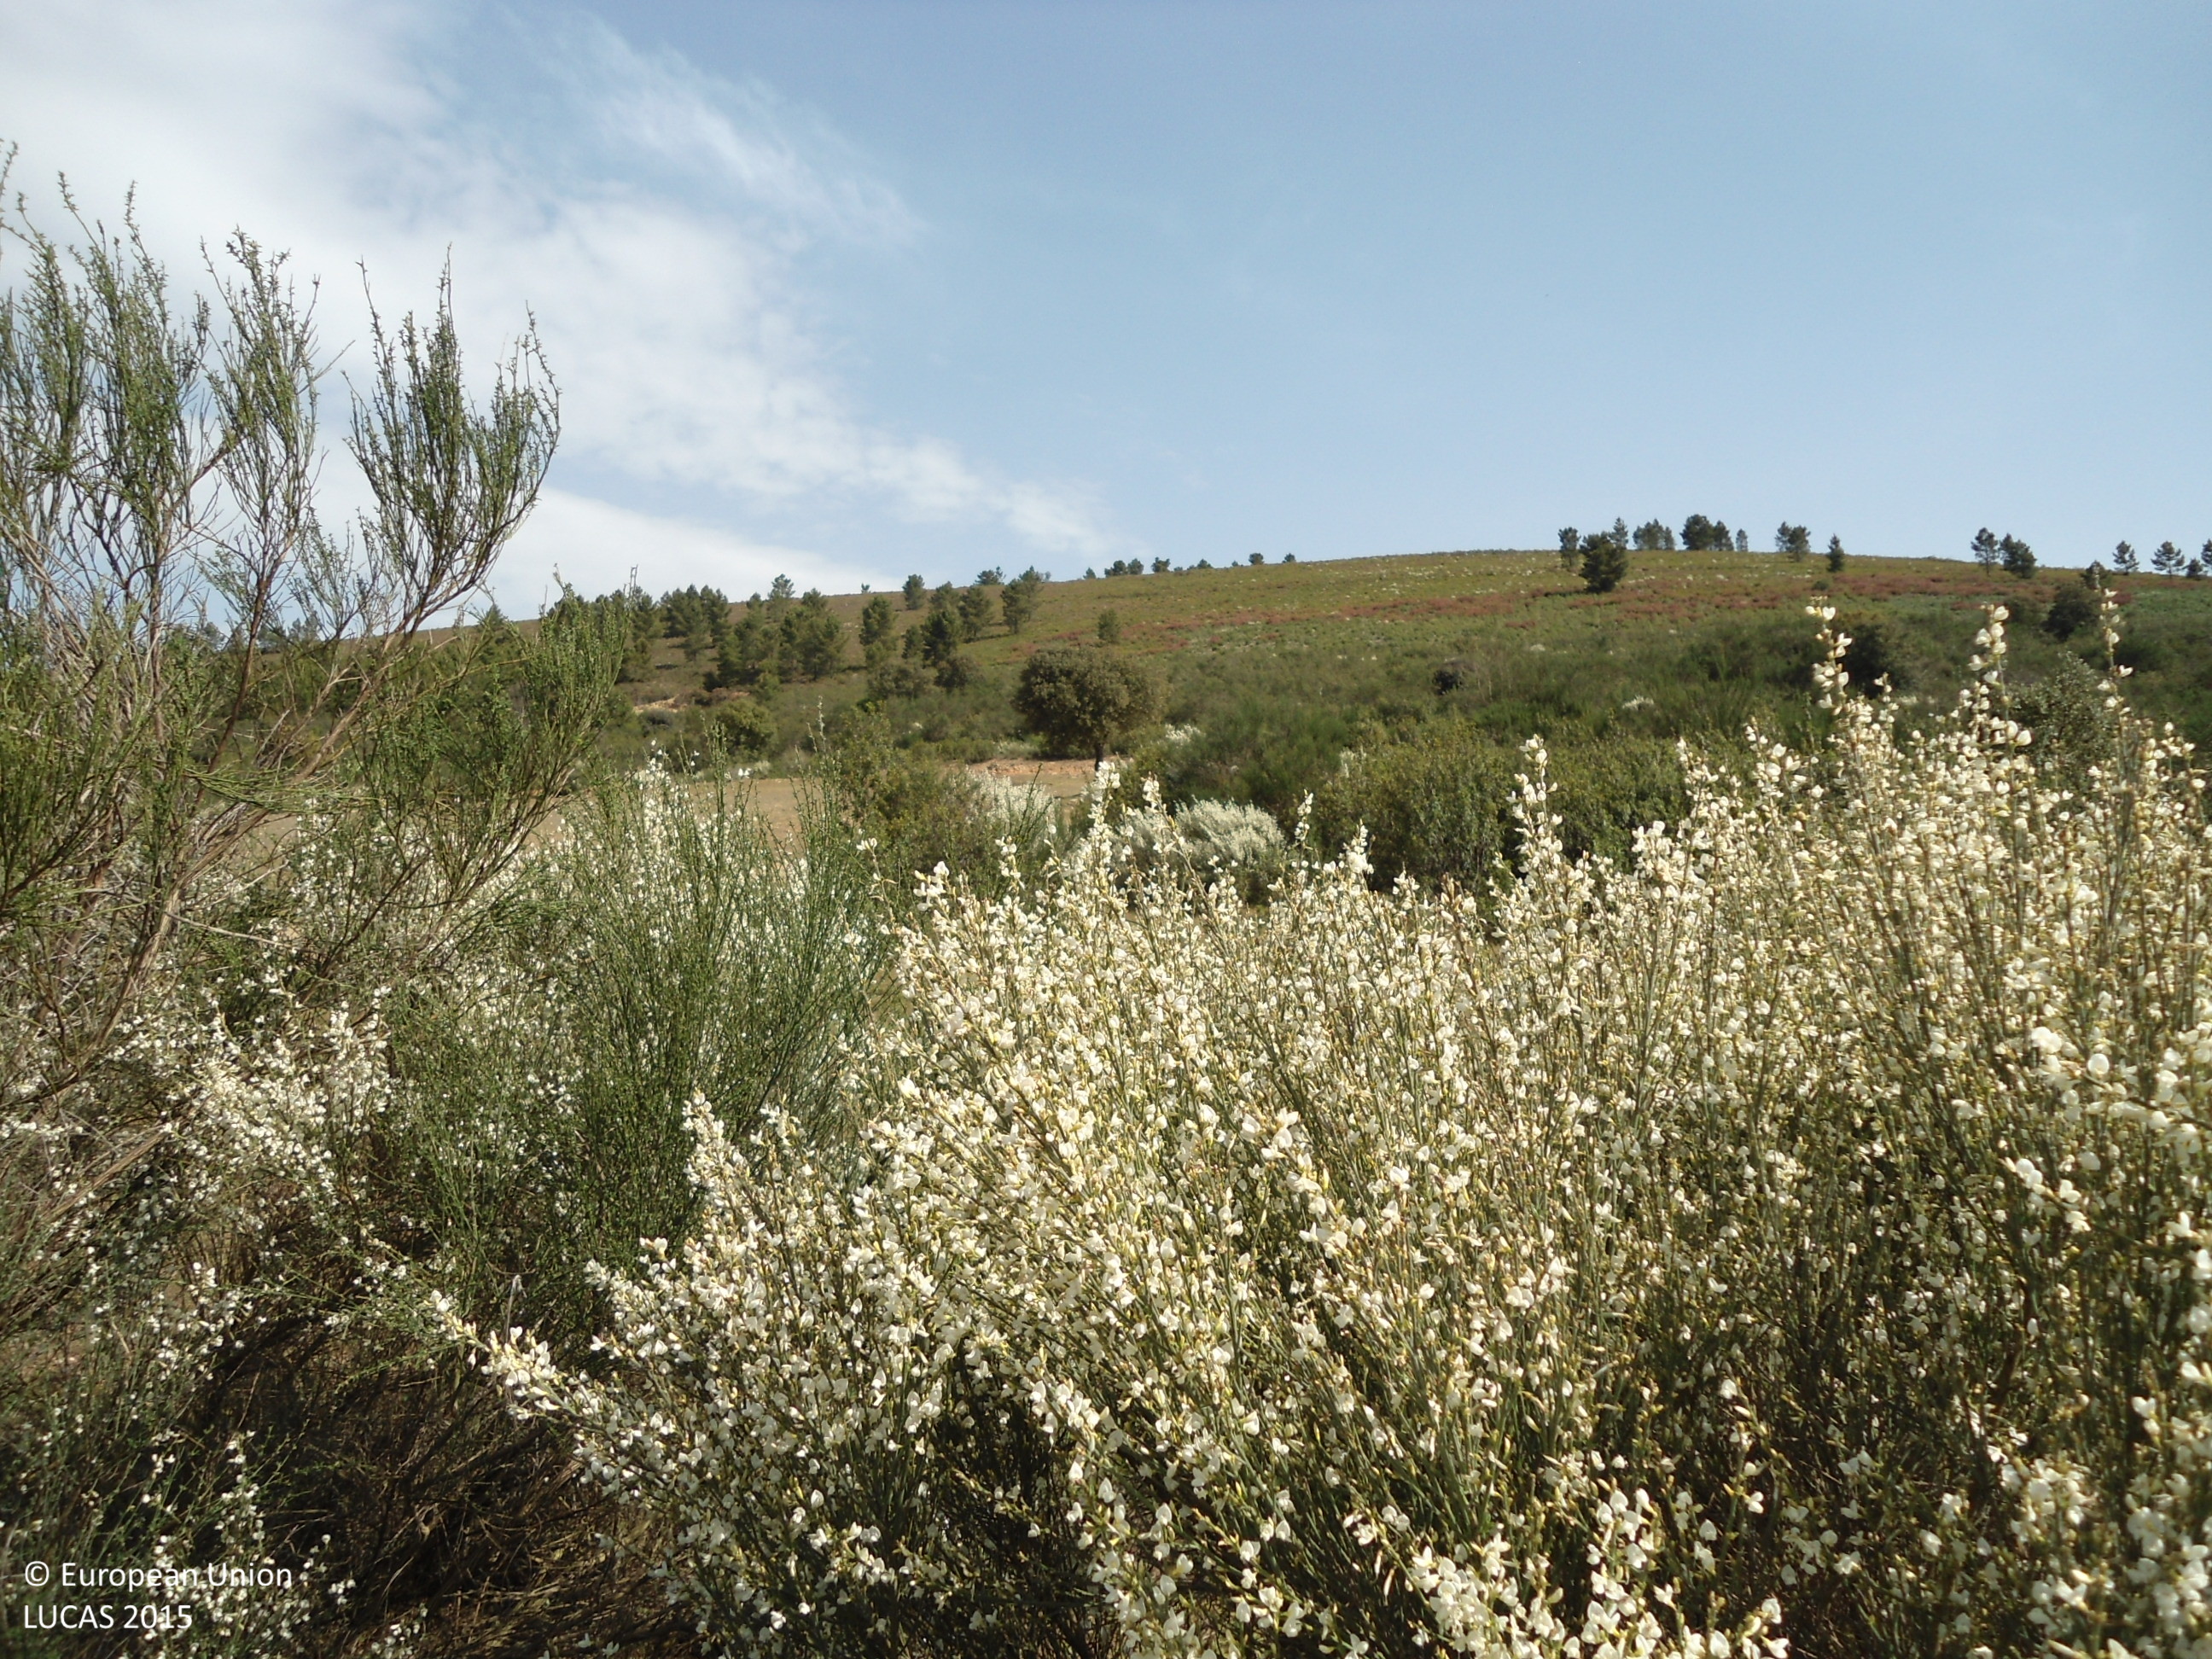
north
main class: Shrubland
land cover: Shrubland without tree cover
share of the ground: > 75 %
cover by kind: shrubs 95 %, herbaceous plants 5 %
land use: Semi-natural and natural areas not in use
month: April
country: ES
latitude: 41.6759
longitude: -6.5017
